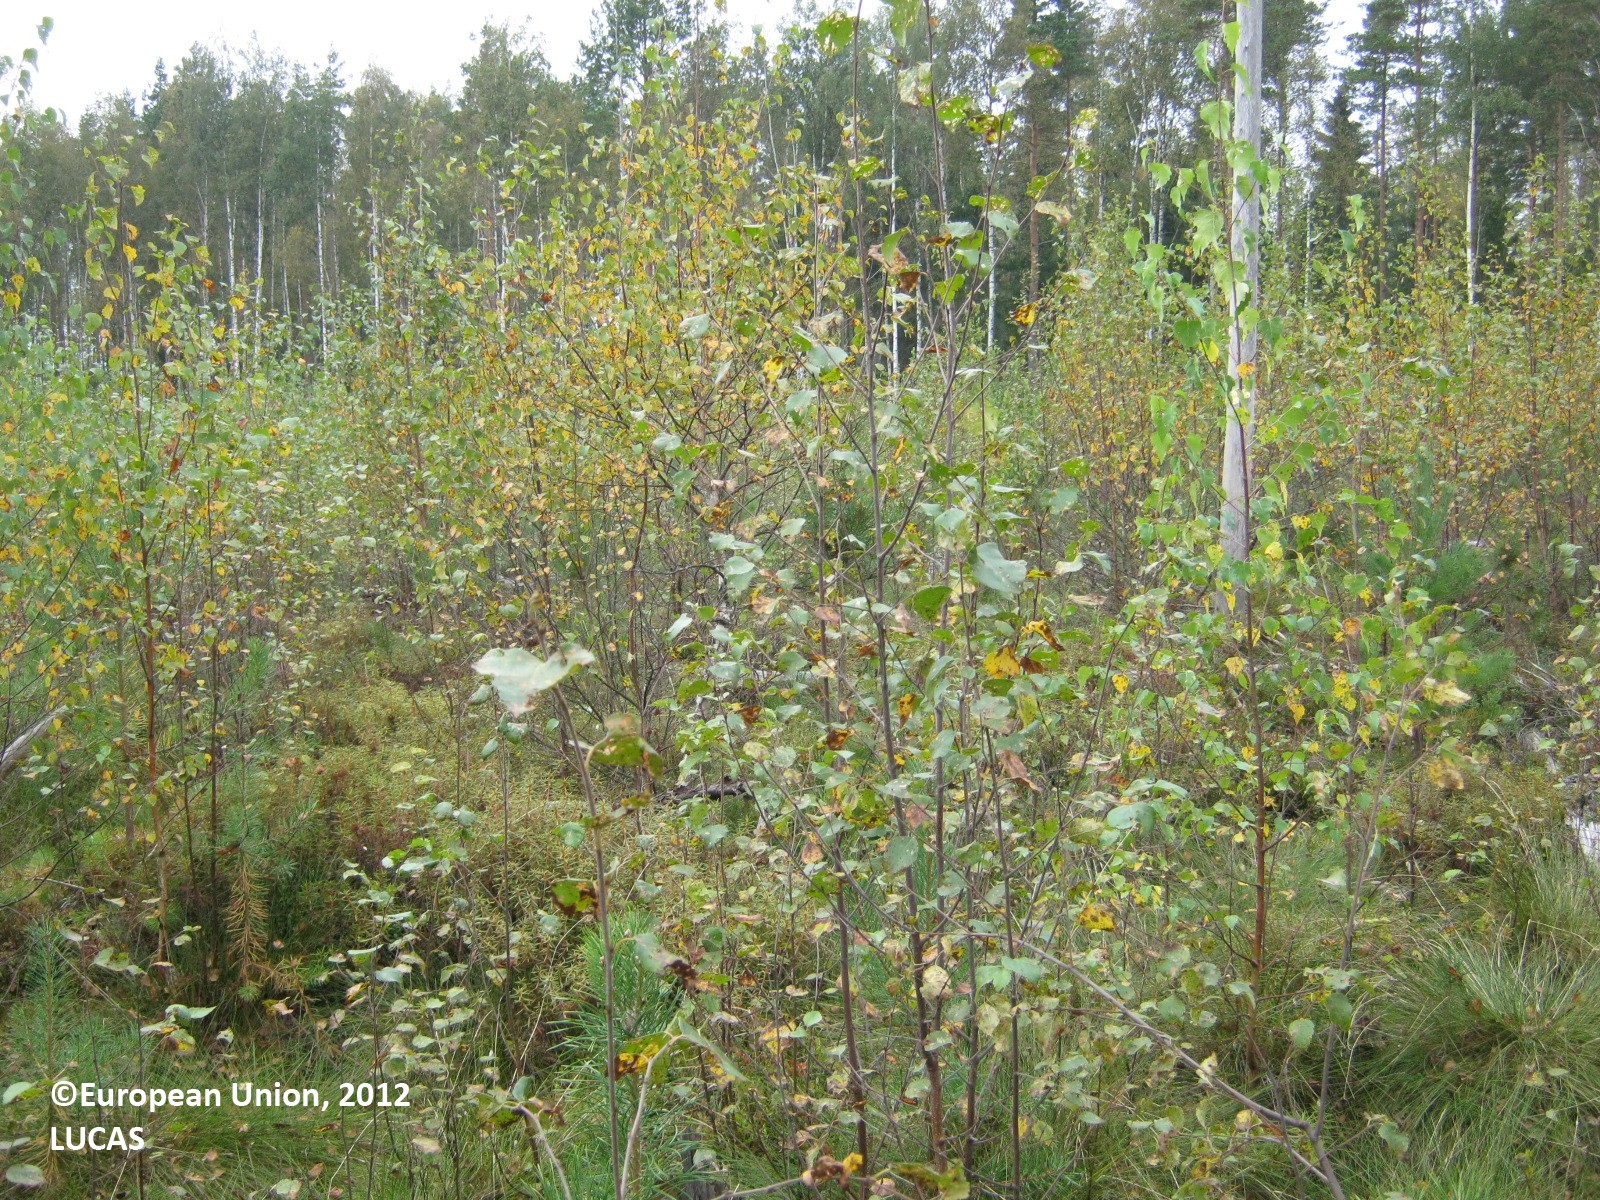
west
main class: Woodland
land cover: Broadleaved woodland
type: boreal forest
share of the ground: > 75 %
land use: Forestry
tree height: < 5 m
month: September
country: FI
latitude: 60.6592
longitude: 27.5491
